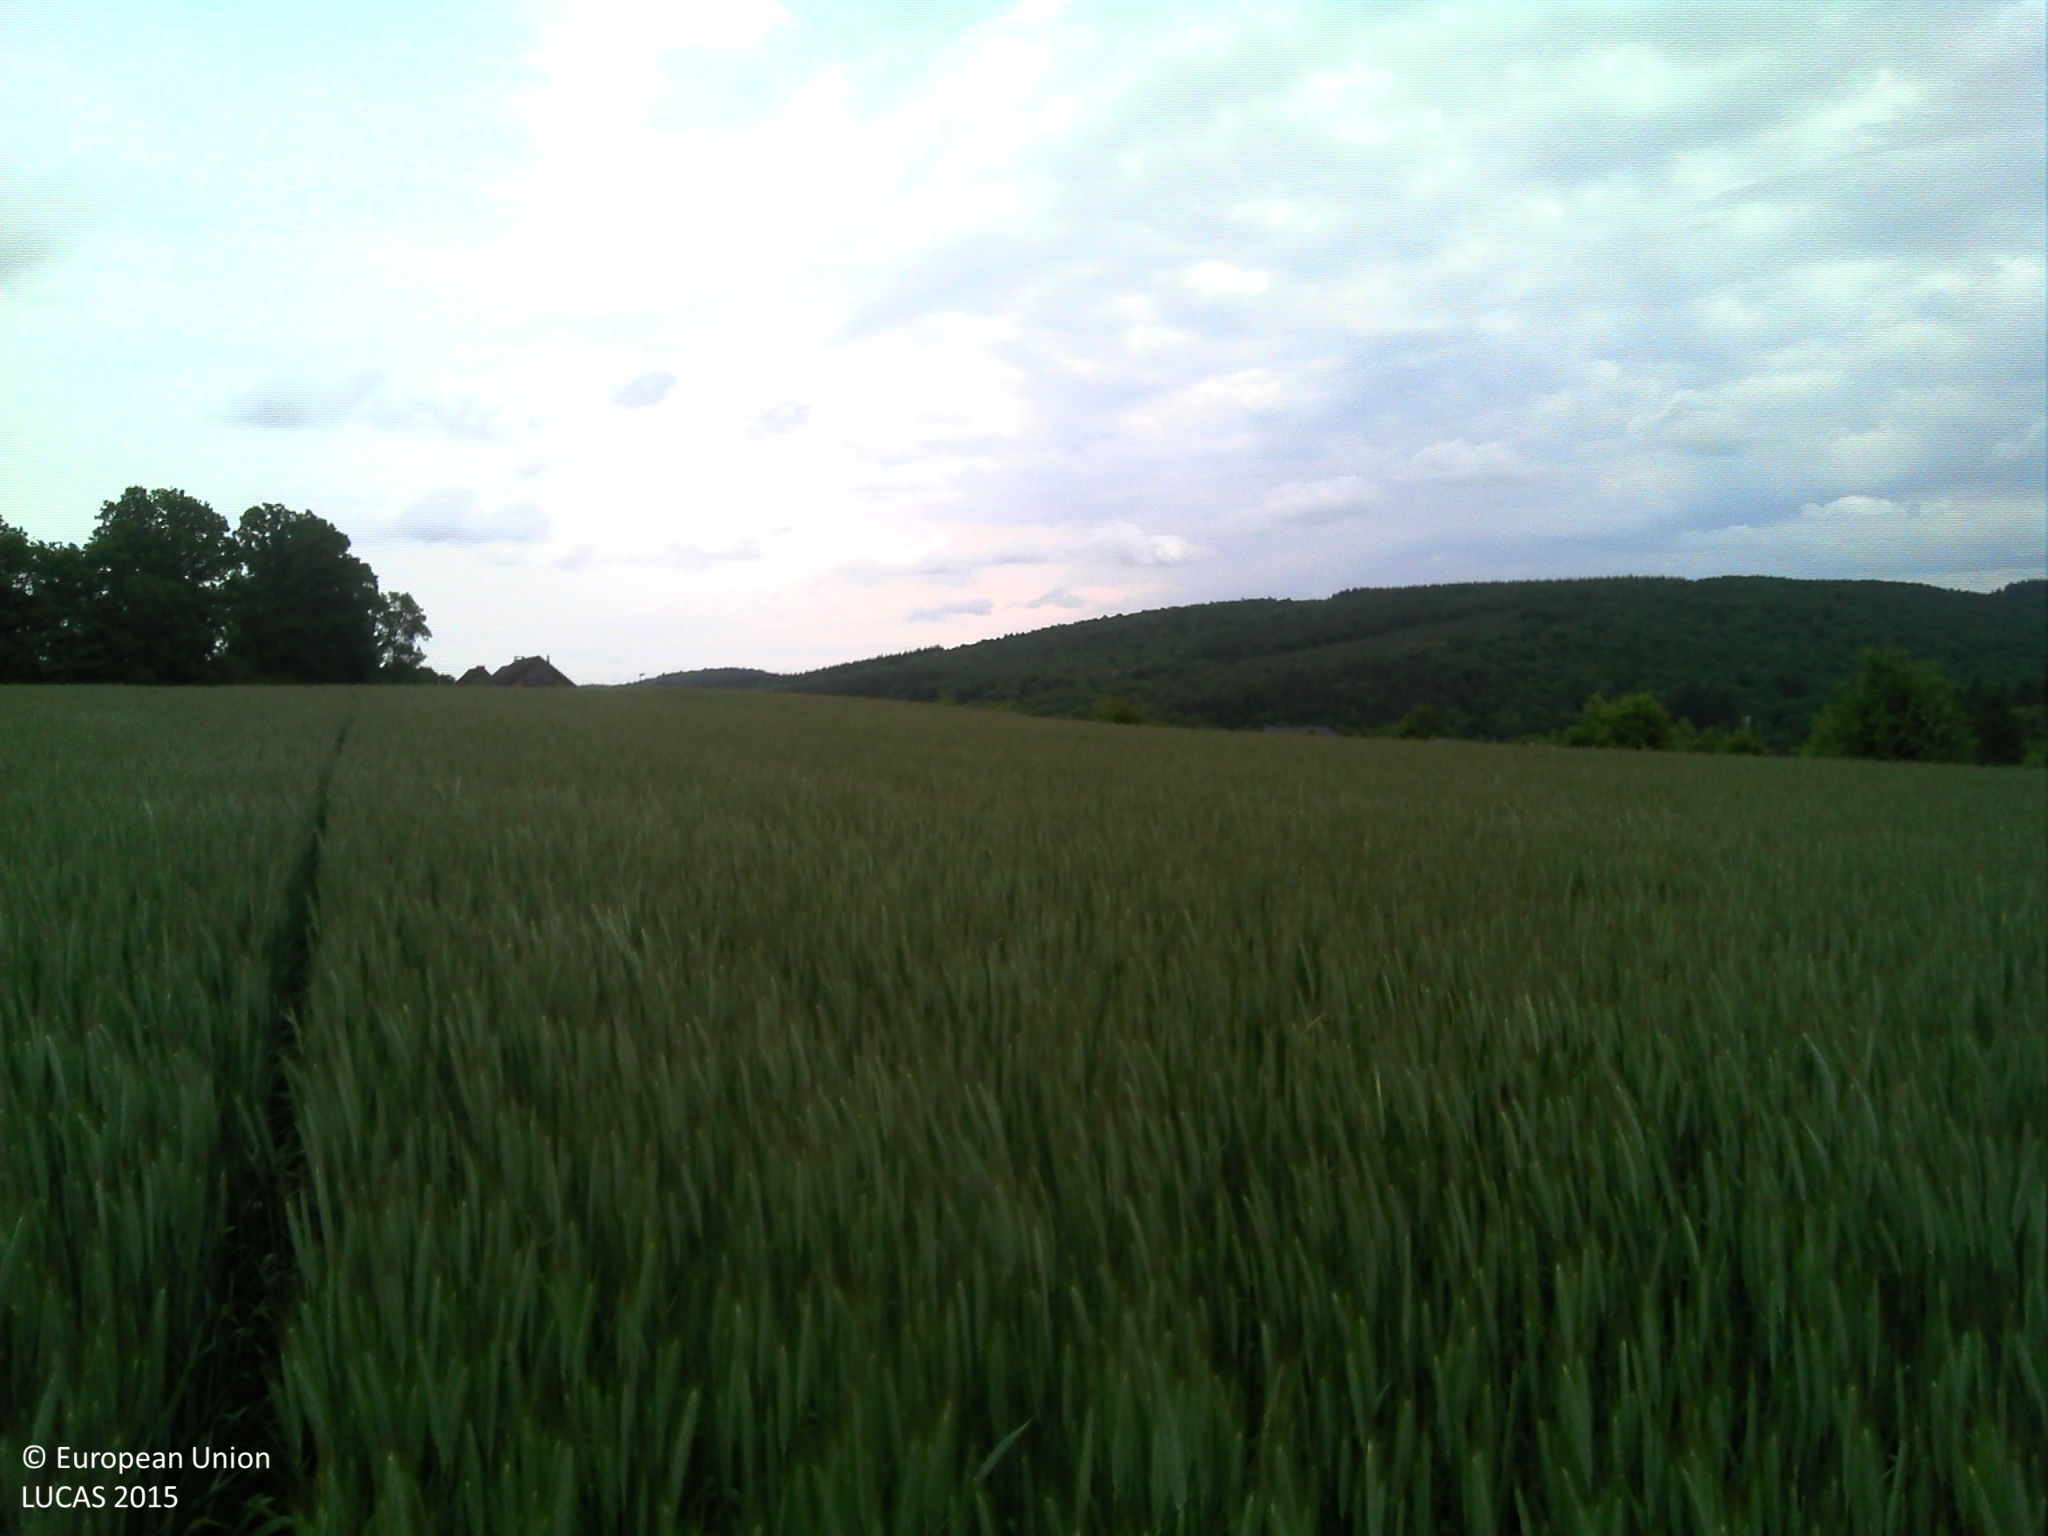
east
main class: Cropland
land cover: Triticale
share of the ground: > 75 %
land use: Agriculture (excluding fallow land and kitchen gardens)
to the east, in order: Triticale; Grass margins; Paved roads, cycling and walking lanes; Grass margins; Fences; Grassland without tree/shrub cover; Fences; Grassland without tree/shrub cover; Fences; Grassland without tree/shrub cover
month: May
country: BE
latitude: 50.1575
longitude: 5.2528
